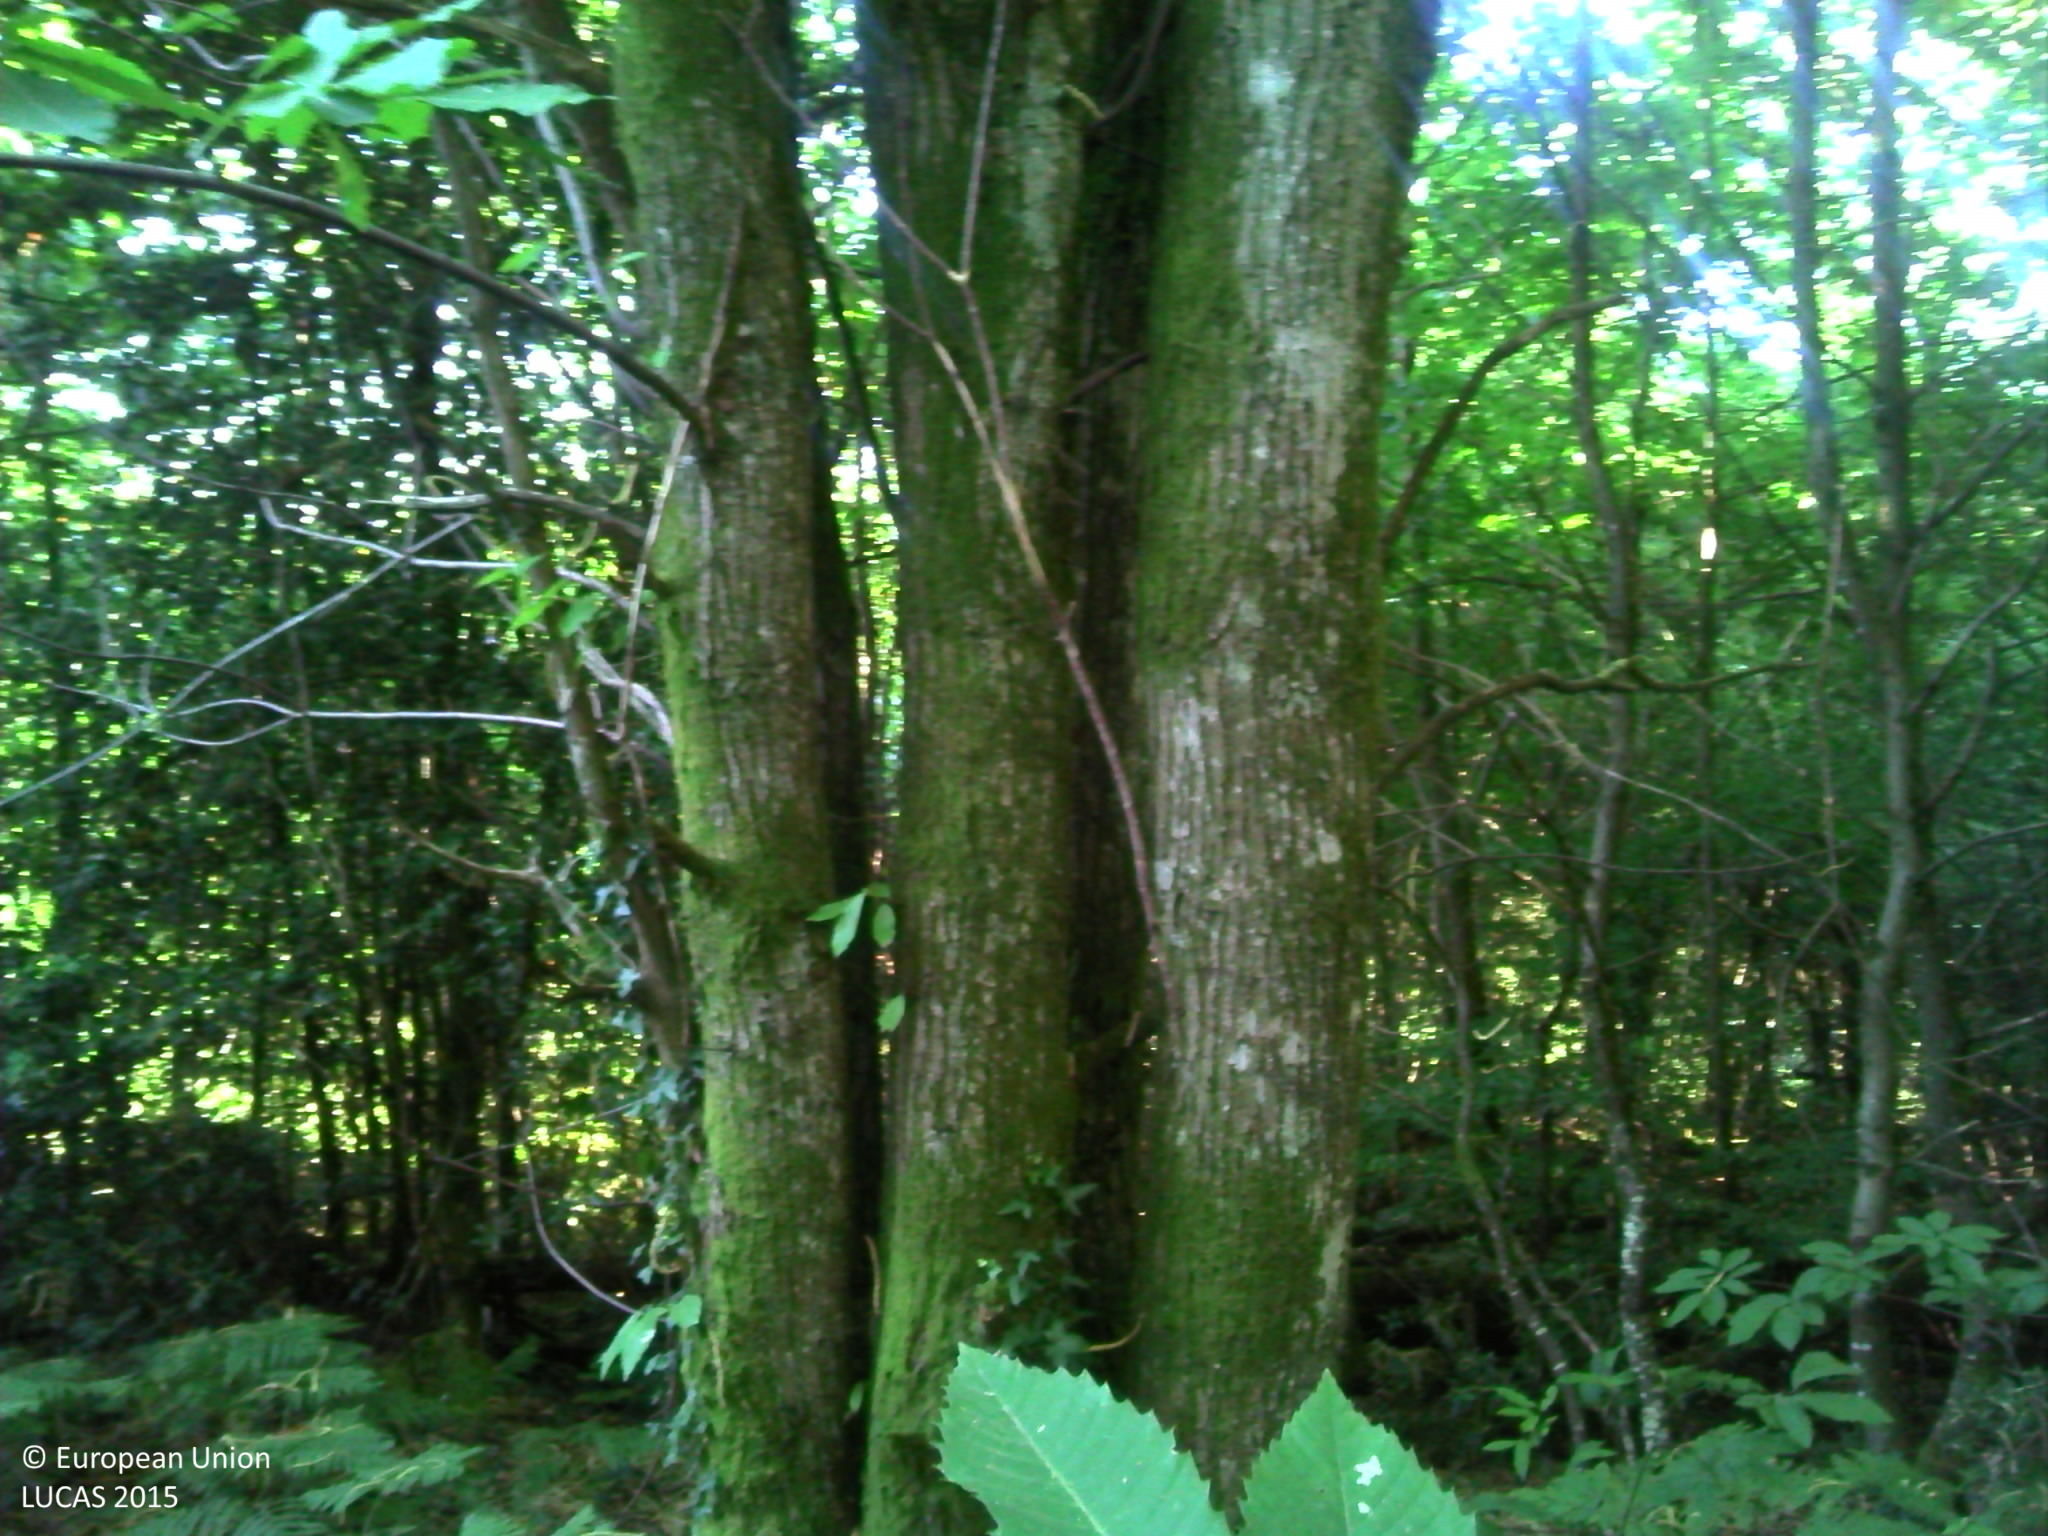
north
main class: Woodland
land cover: Broadleaved woodland
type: mesophytic deciduous forest
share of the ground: > 75 %
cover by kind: broadleaved forest trees 80 %, shrubs 10 %, herbaceous plants 10 %
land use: Forestry
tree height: > 5 m
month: July
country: FR
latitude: 46.2157
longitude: 1.5522
